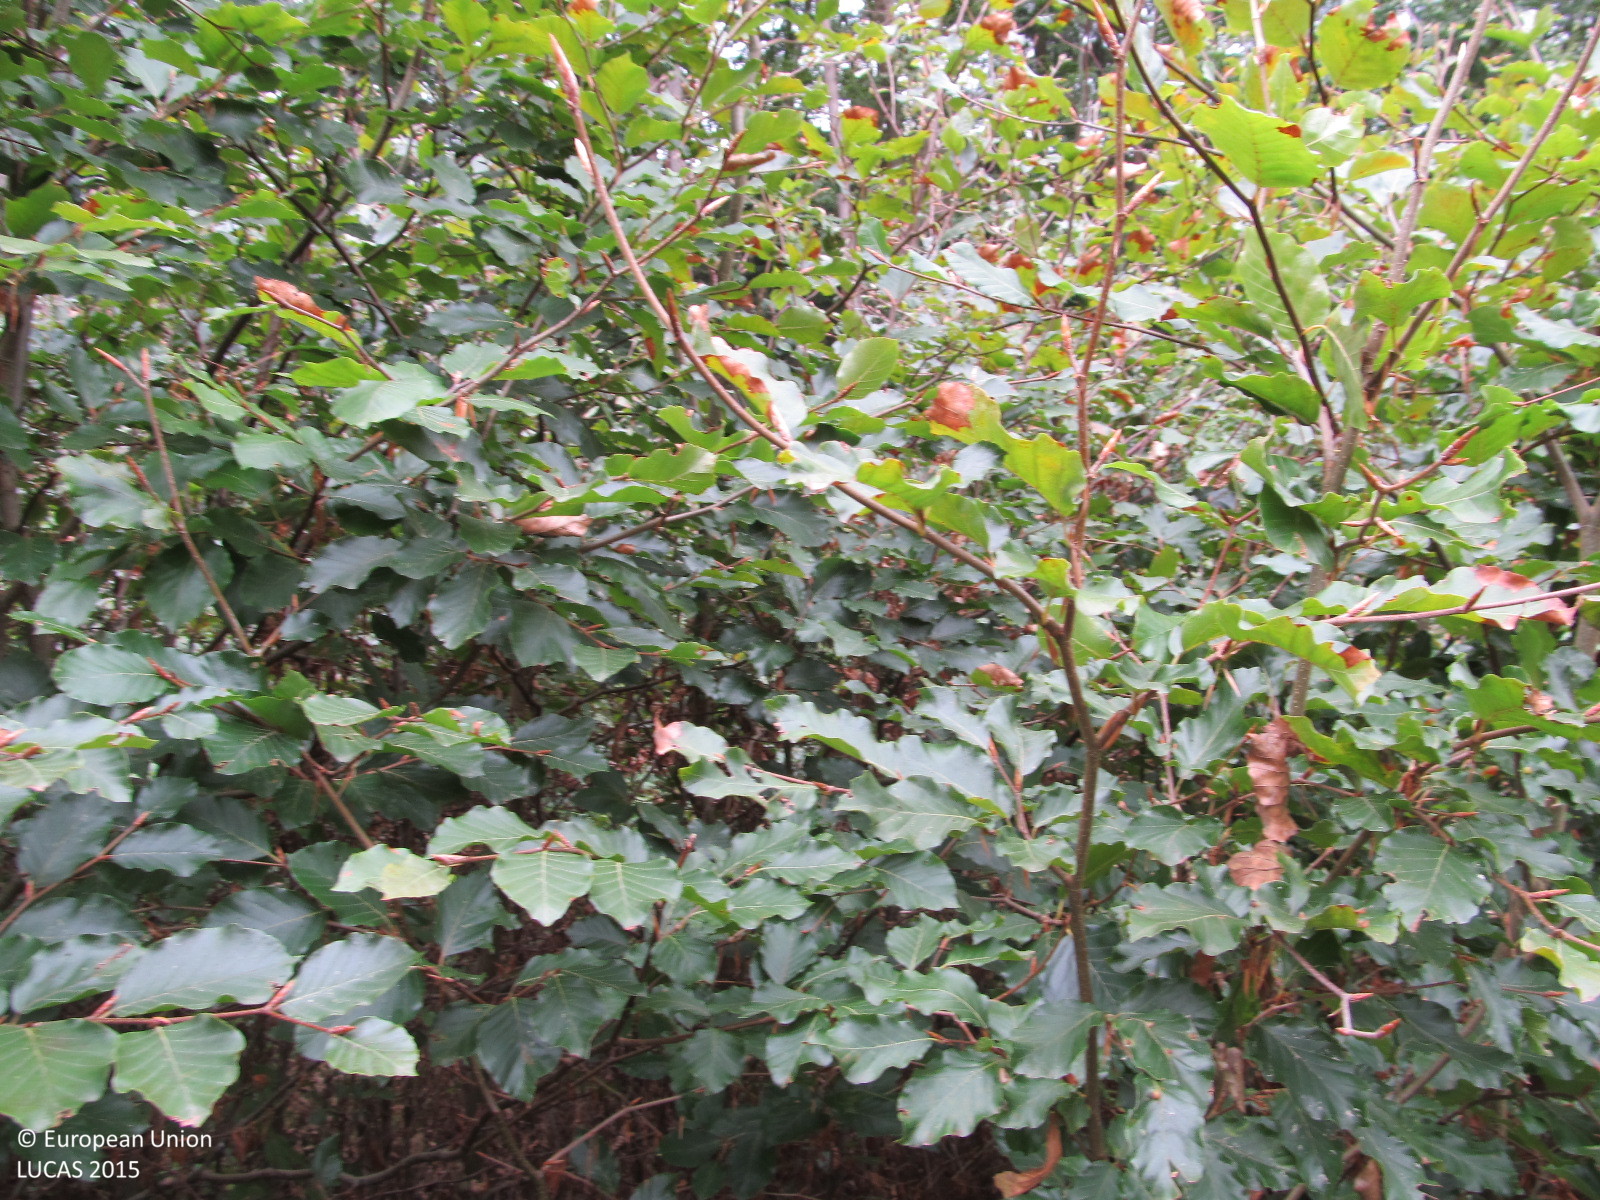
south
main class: Woodland
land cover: Broadleaved woodland
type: hemiboreal forest and nemoral coniferous forest and mixed broadleaved-coniferous forest
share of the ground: > 75 %
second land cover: Spontaneously vegetated surfaces
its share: 10 - 25 %
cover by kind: broadleaved forest trees 80 %, herbaceous plants 20 %
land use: Forestry
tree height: < 5 m
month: September
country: AT
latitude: 48.3391
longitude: 15.4934
